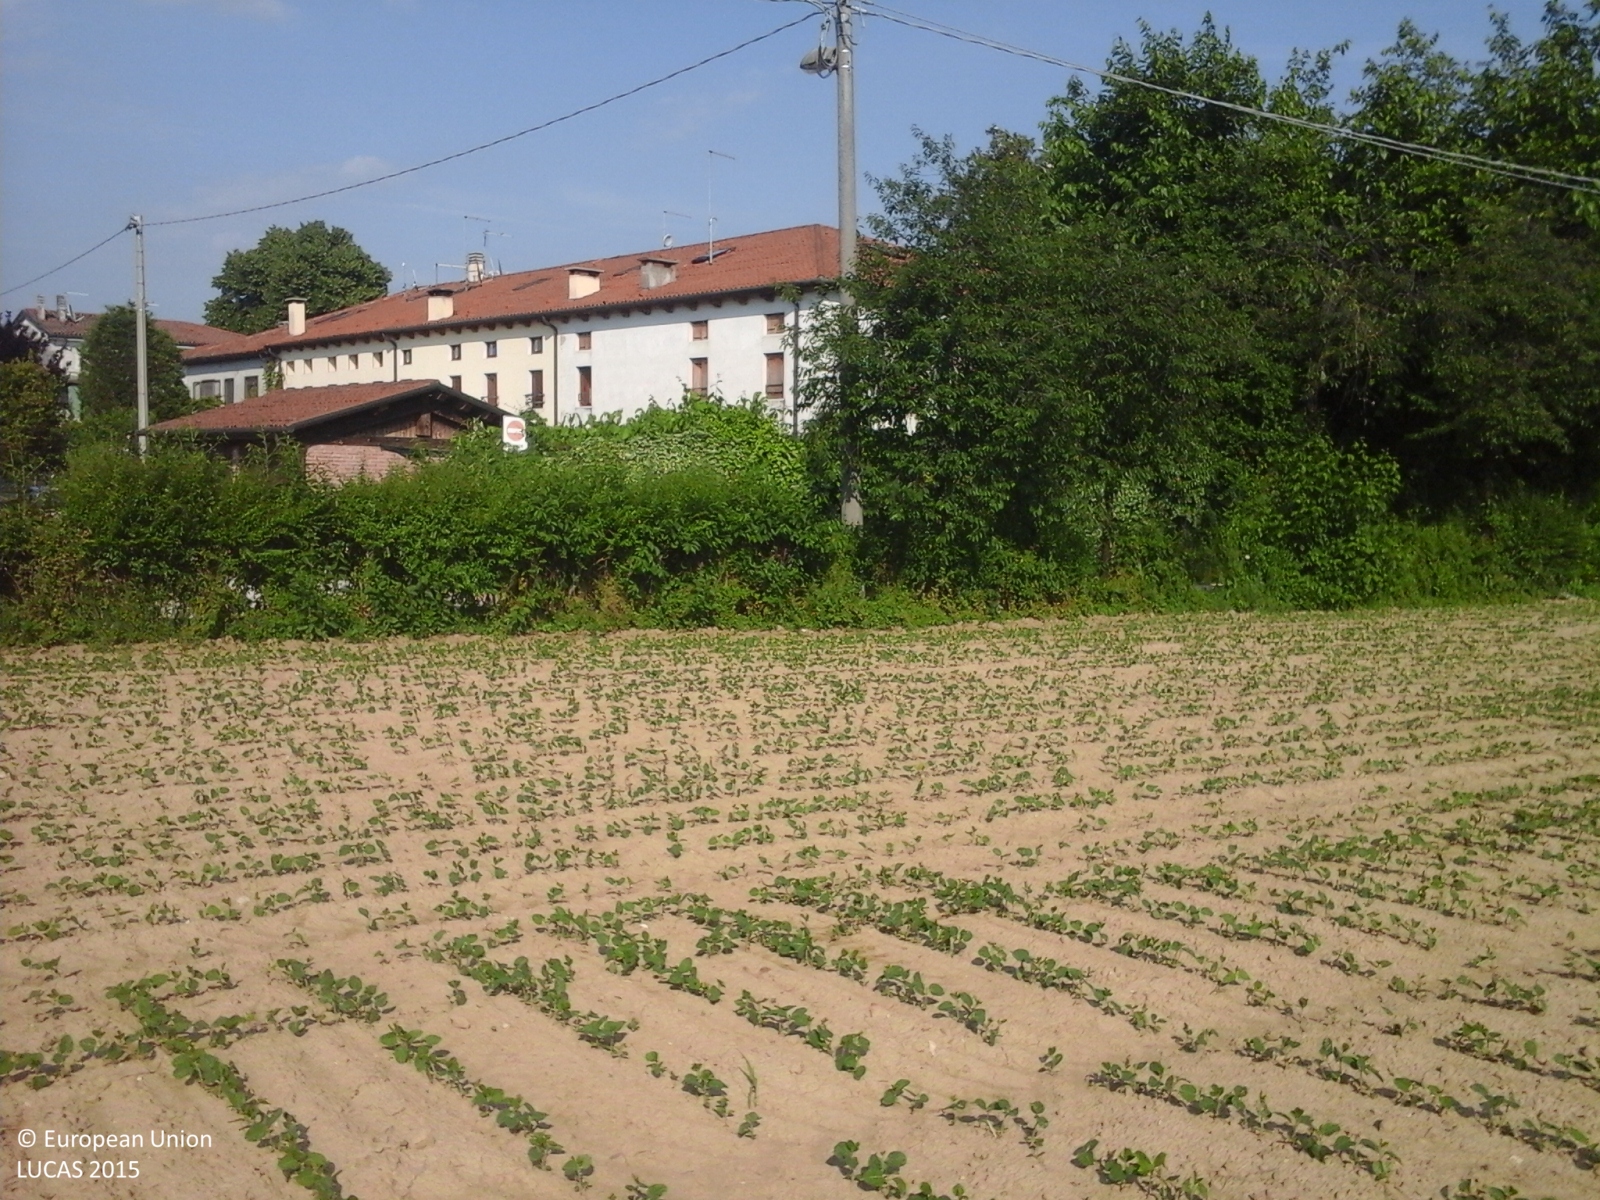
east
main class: Cropland
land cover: Soya
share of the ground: < 10 %
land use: Agriculture (excluding fallow land and kitchen gardens)
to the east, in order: Soya; Managed hedges; Artificial constructions in urban areas; Grassland without tree/shrub cover; Soya
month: May
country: IT
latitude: 45.5648
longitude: 11.5734
